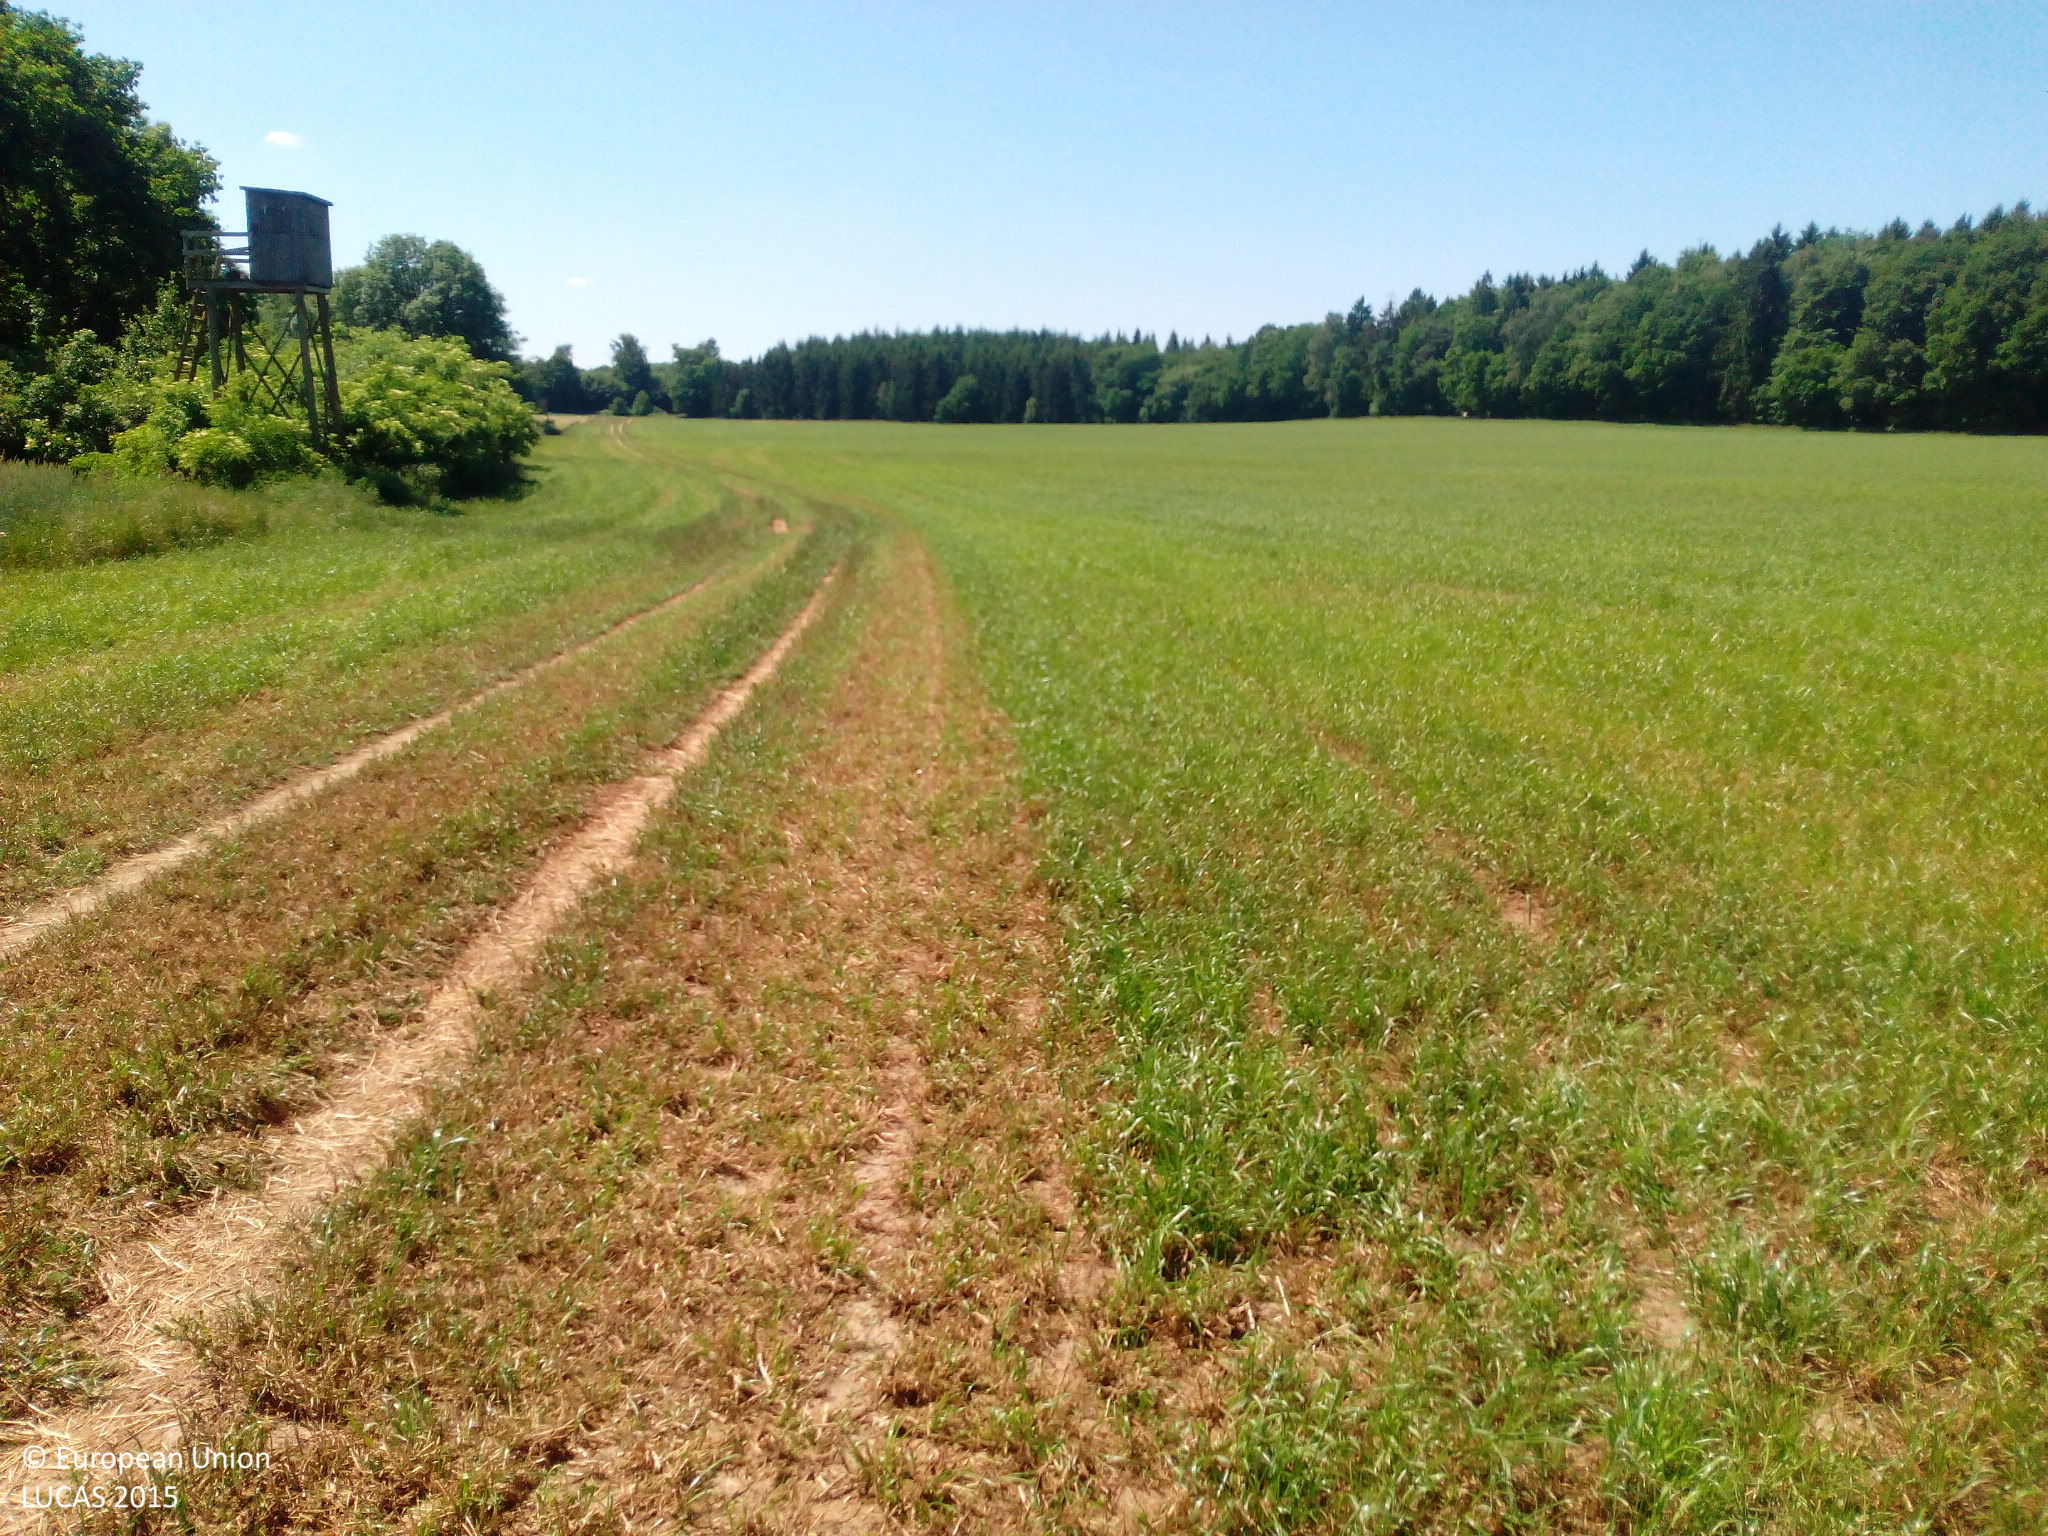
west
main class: Cropland
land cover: Temporary grasslands
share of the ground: > 75 %
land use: Agriculture (excluding fallow land and kitchen gardens)
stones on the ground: < 10 %
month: June
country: DE
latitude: 53.3772
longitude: 12.4496
